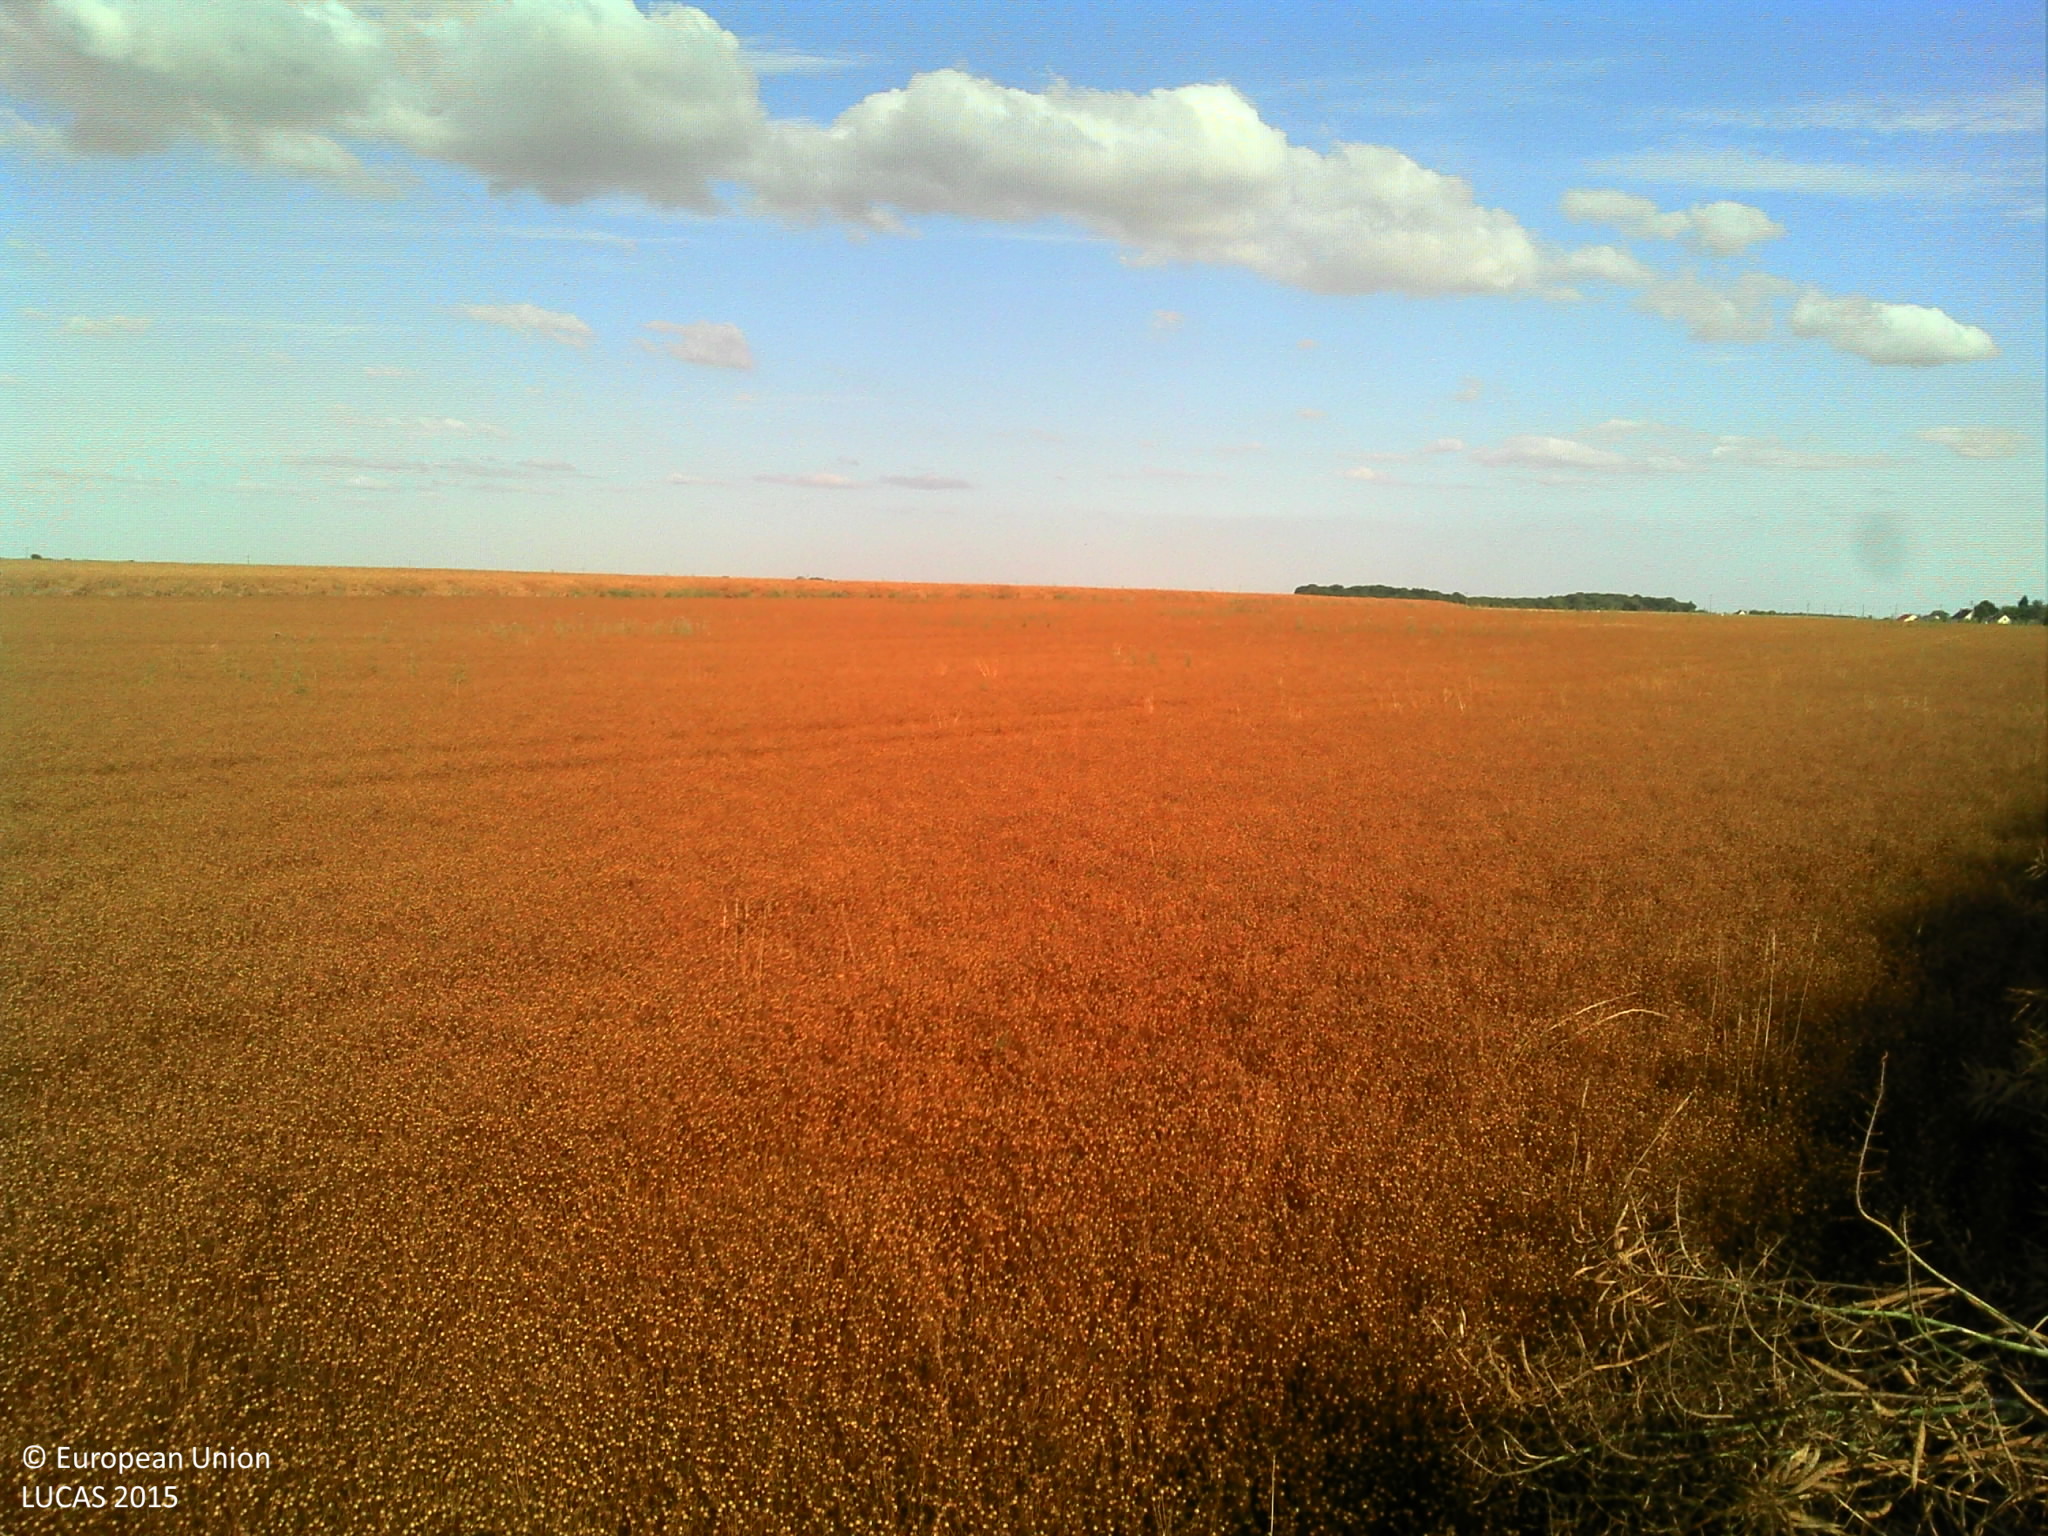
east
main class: Cropland
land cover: Rape and turnip rape
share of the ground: > 75 %
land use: Agriculture (excluding fallow land and kitchen gardens)
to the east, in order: Rape and turnip rape; Other fibre and oleaginous crops; Rape and turnip rape
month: July
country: FR
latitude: 48.3301
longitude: 1.2818
